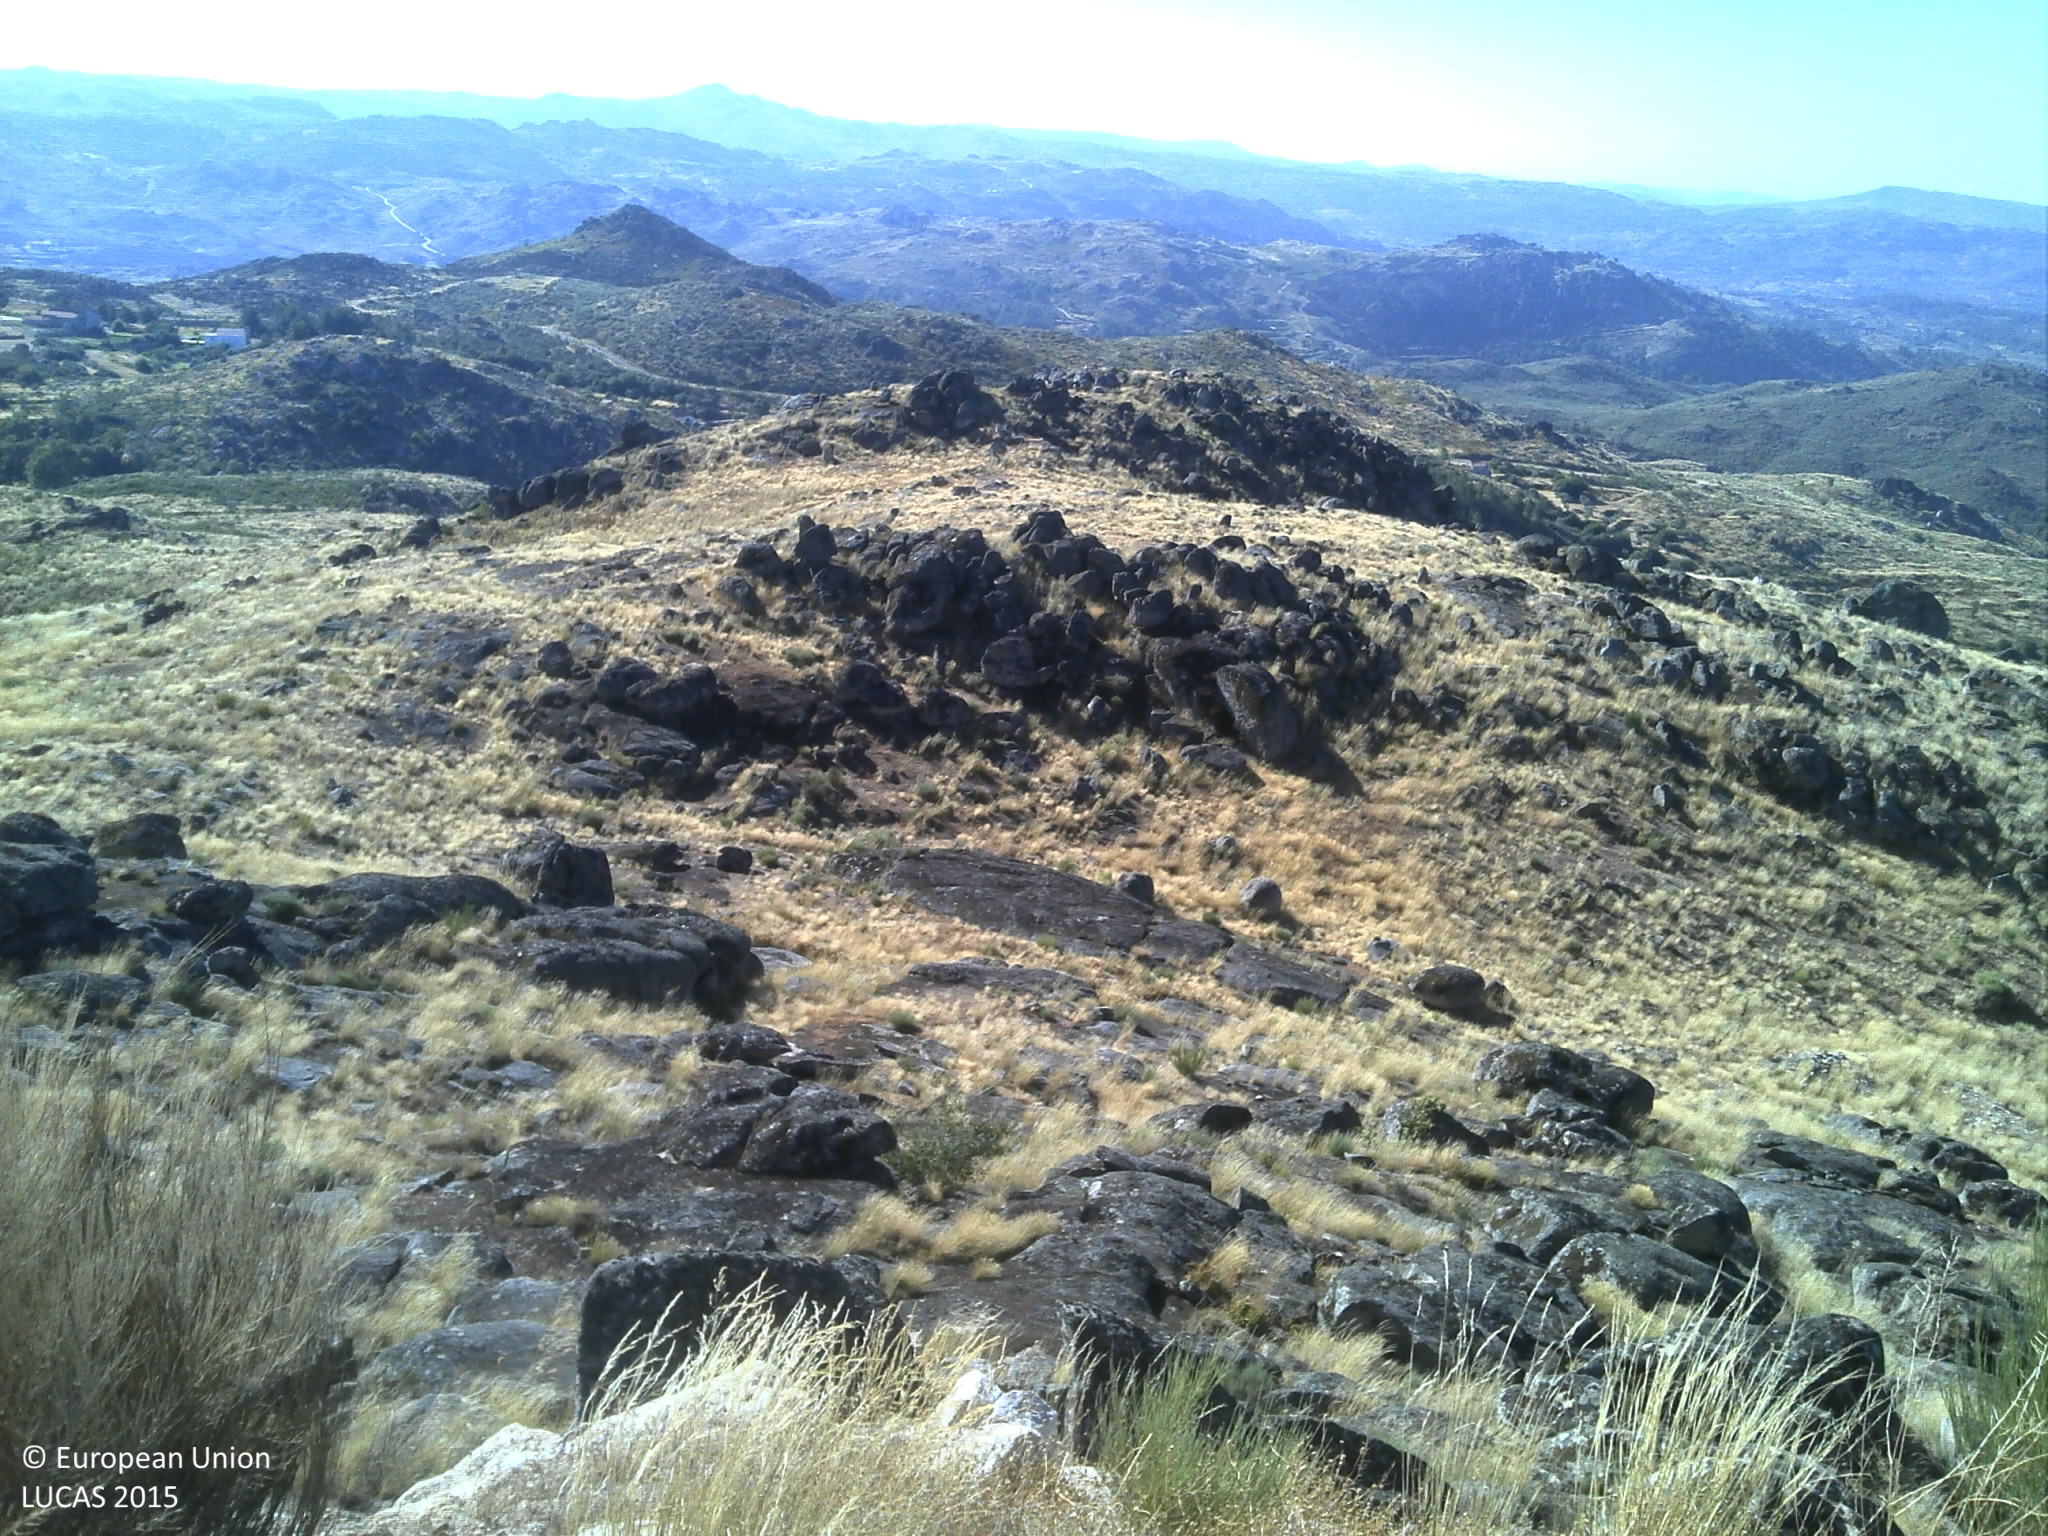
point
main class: Shrubland
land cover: Shrubland without tree cover
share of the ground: 50 - 75 %
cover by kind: shrubs 60 %, unconsolidated bare surface 20 %, herbaceous plants 10 %
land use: Semi-natural and natural areas not in use
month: July
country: PT
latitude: 40.4013
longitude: -7.2708
